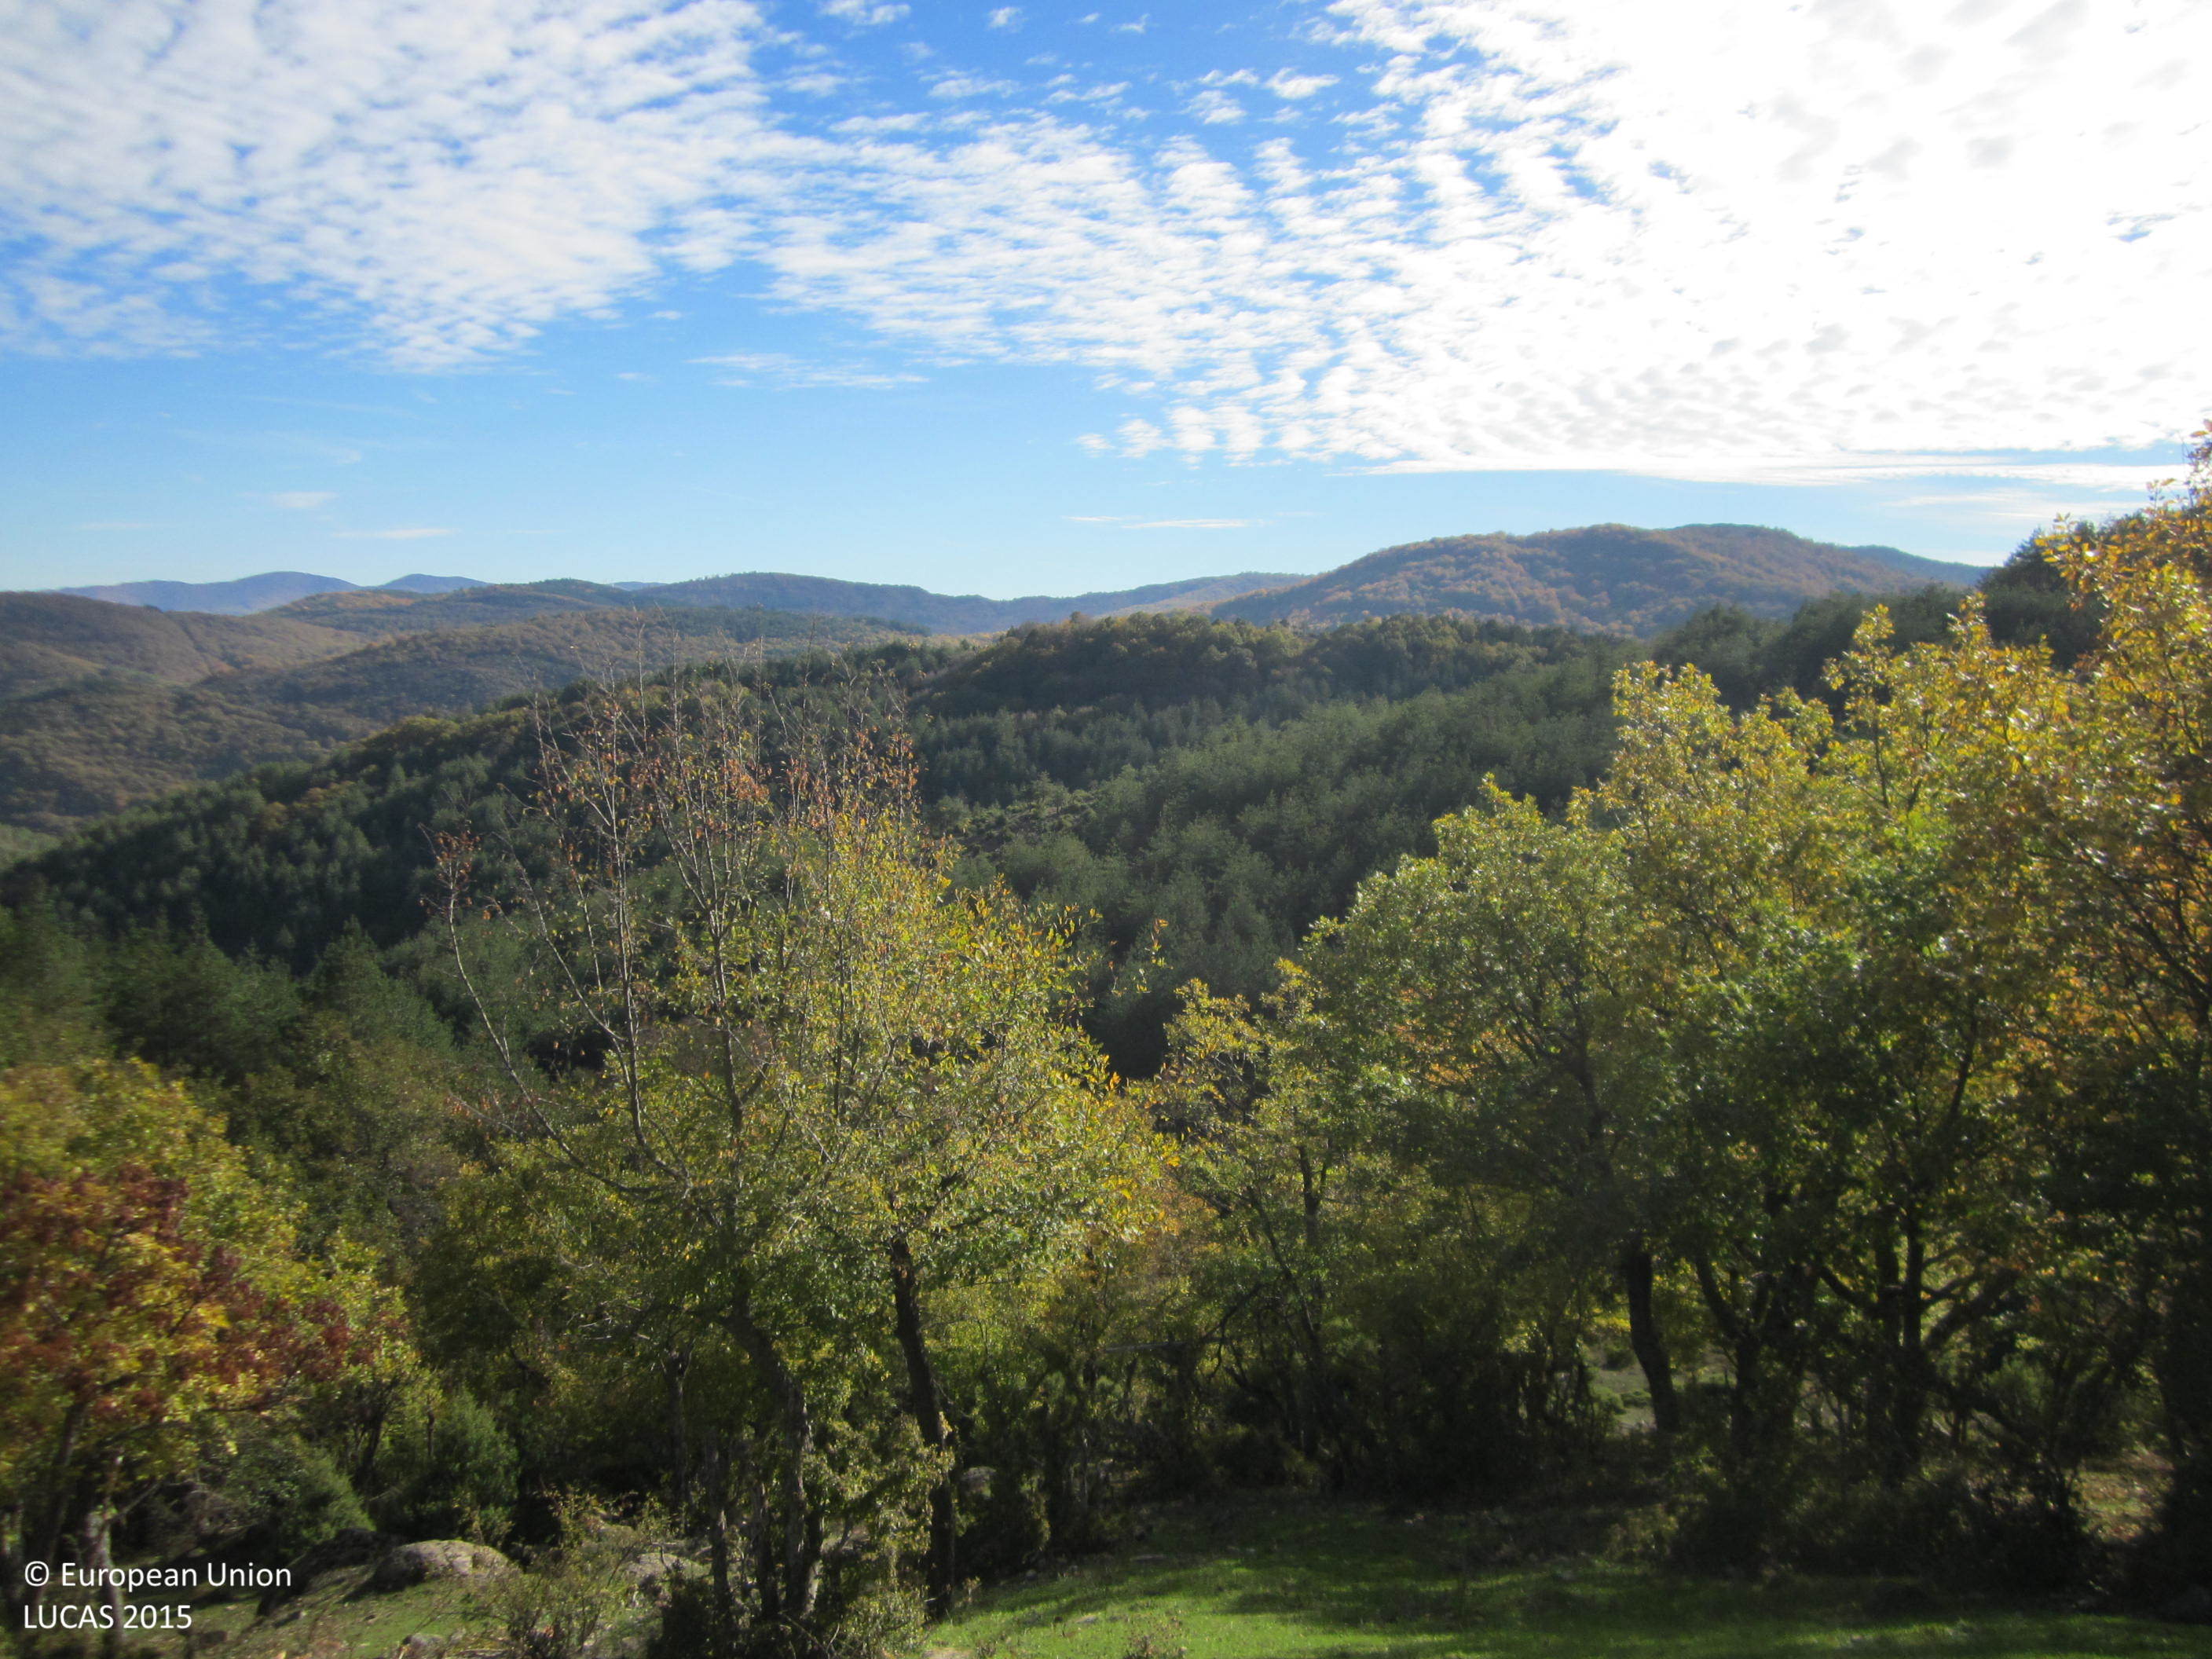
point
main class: Woodland
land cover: Pine dominated coniferous woodland
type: acidophilous oak and oak-birch forest
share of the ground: > 75 %
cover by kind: coniferous forest trees 100 %
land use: Forestry
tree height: > 5 m
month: November
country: BG
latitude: 41.3151
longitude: 25.6713
